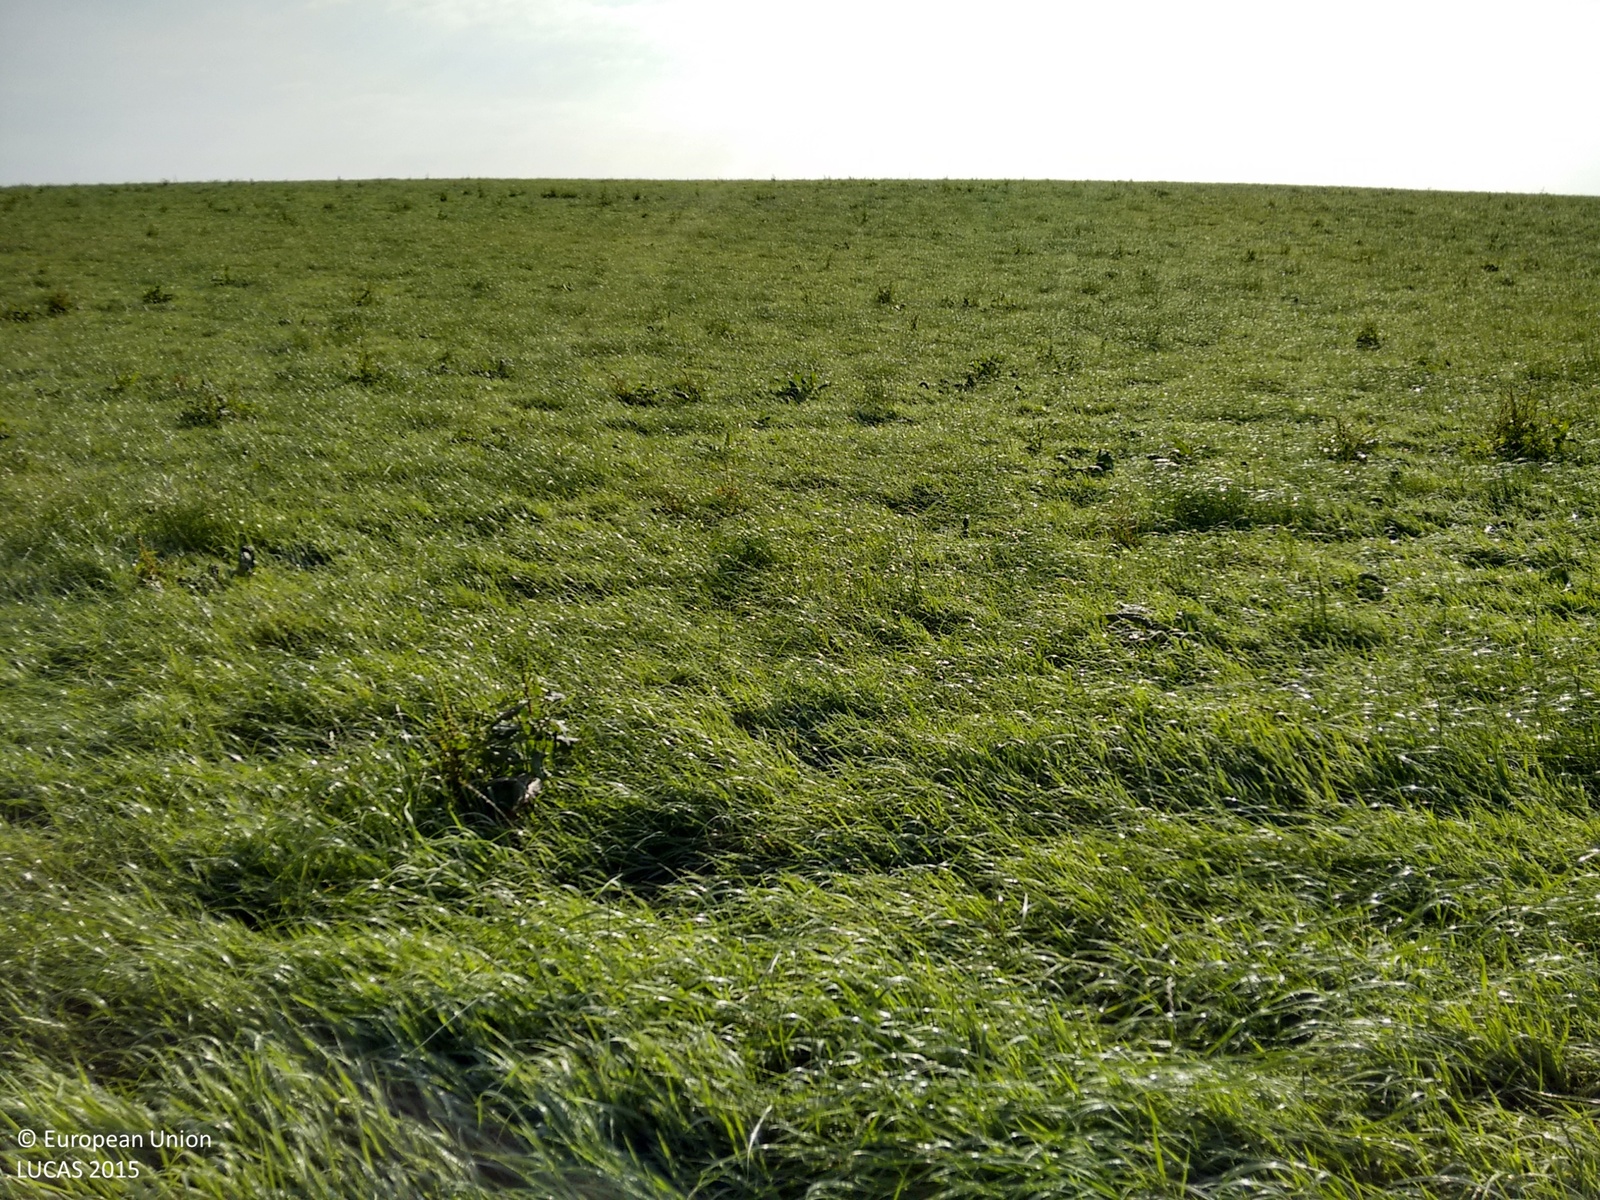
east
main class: Grassland
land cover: Grassland without tree/shrub cover
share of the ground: > 75 %
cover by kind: herbaceous plants 100 %
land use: Agriculture (excluding fallow land and kitchen gardens)
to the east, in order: Grassland without tree/shrub cover
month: August
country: GB
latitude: 54.9052
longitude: -5.0723
